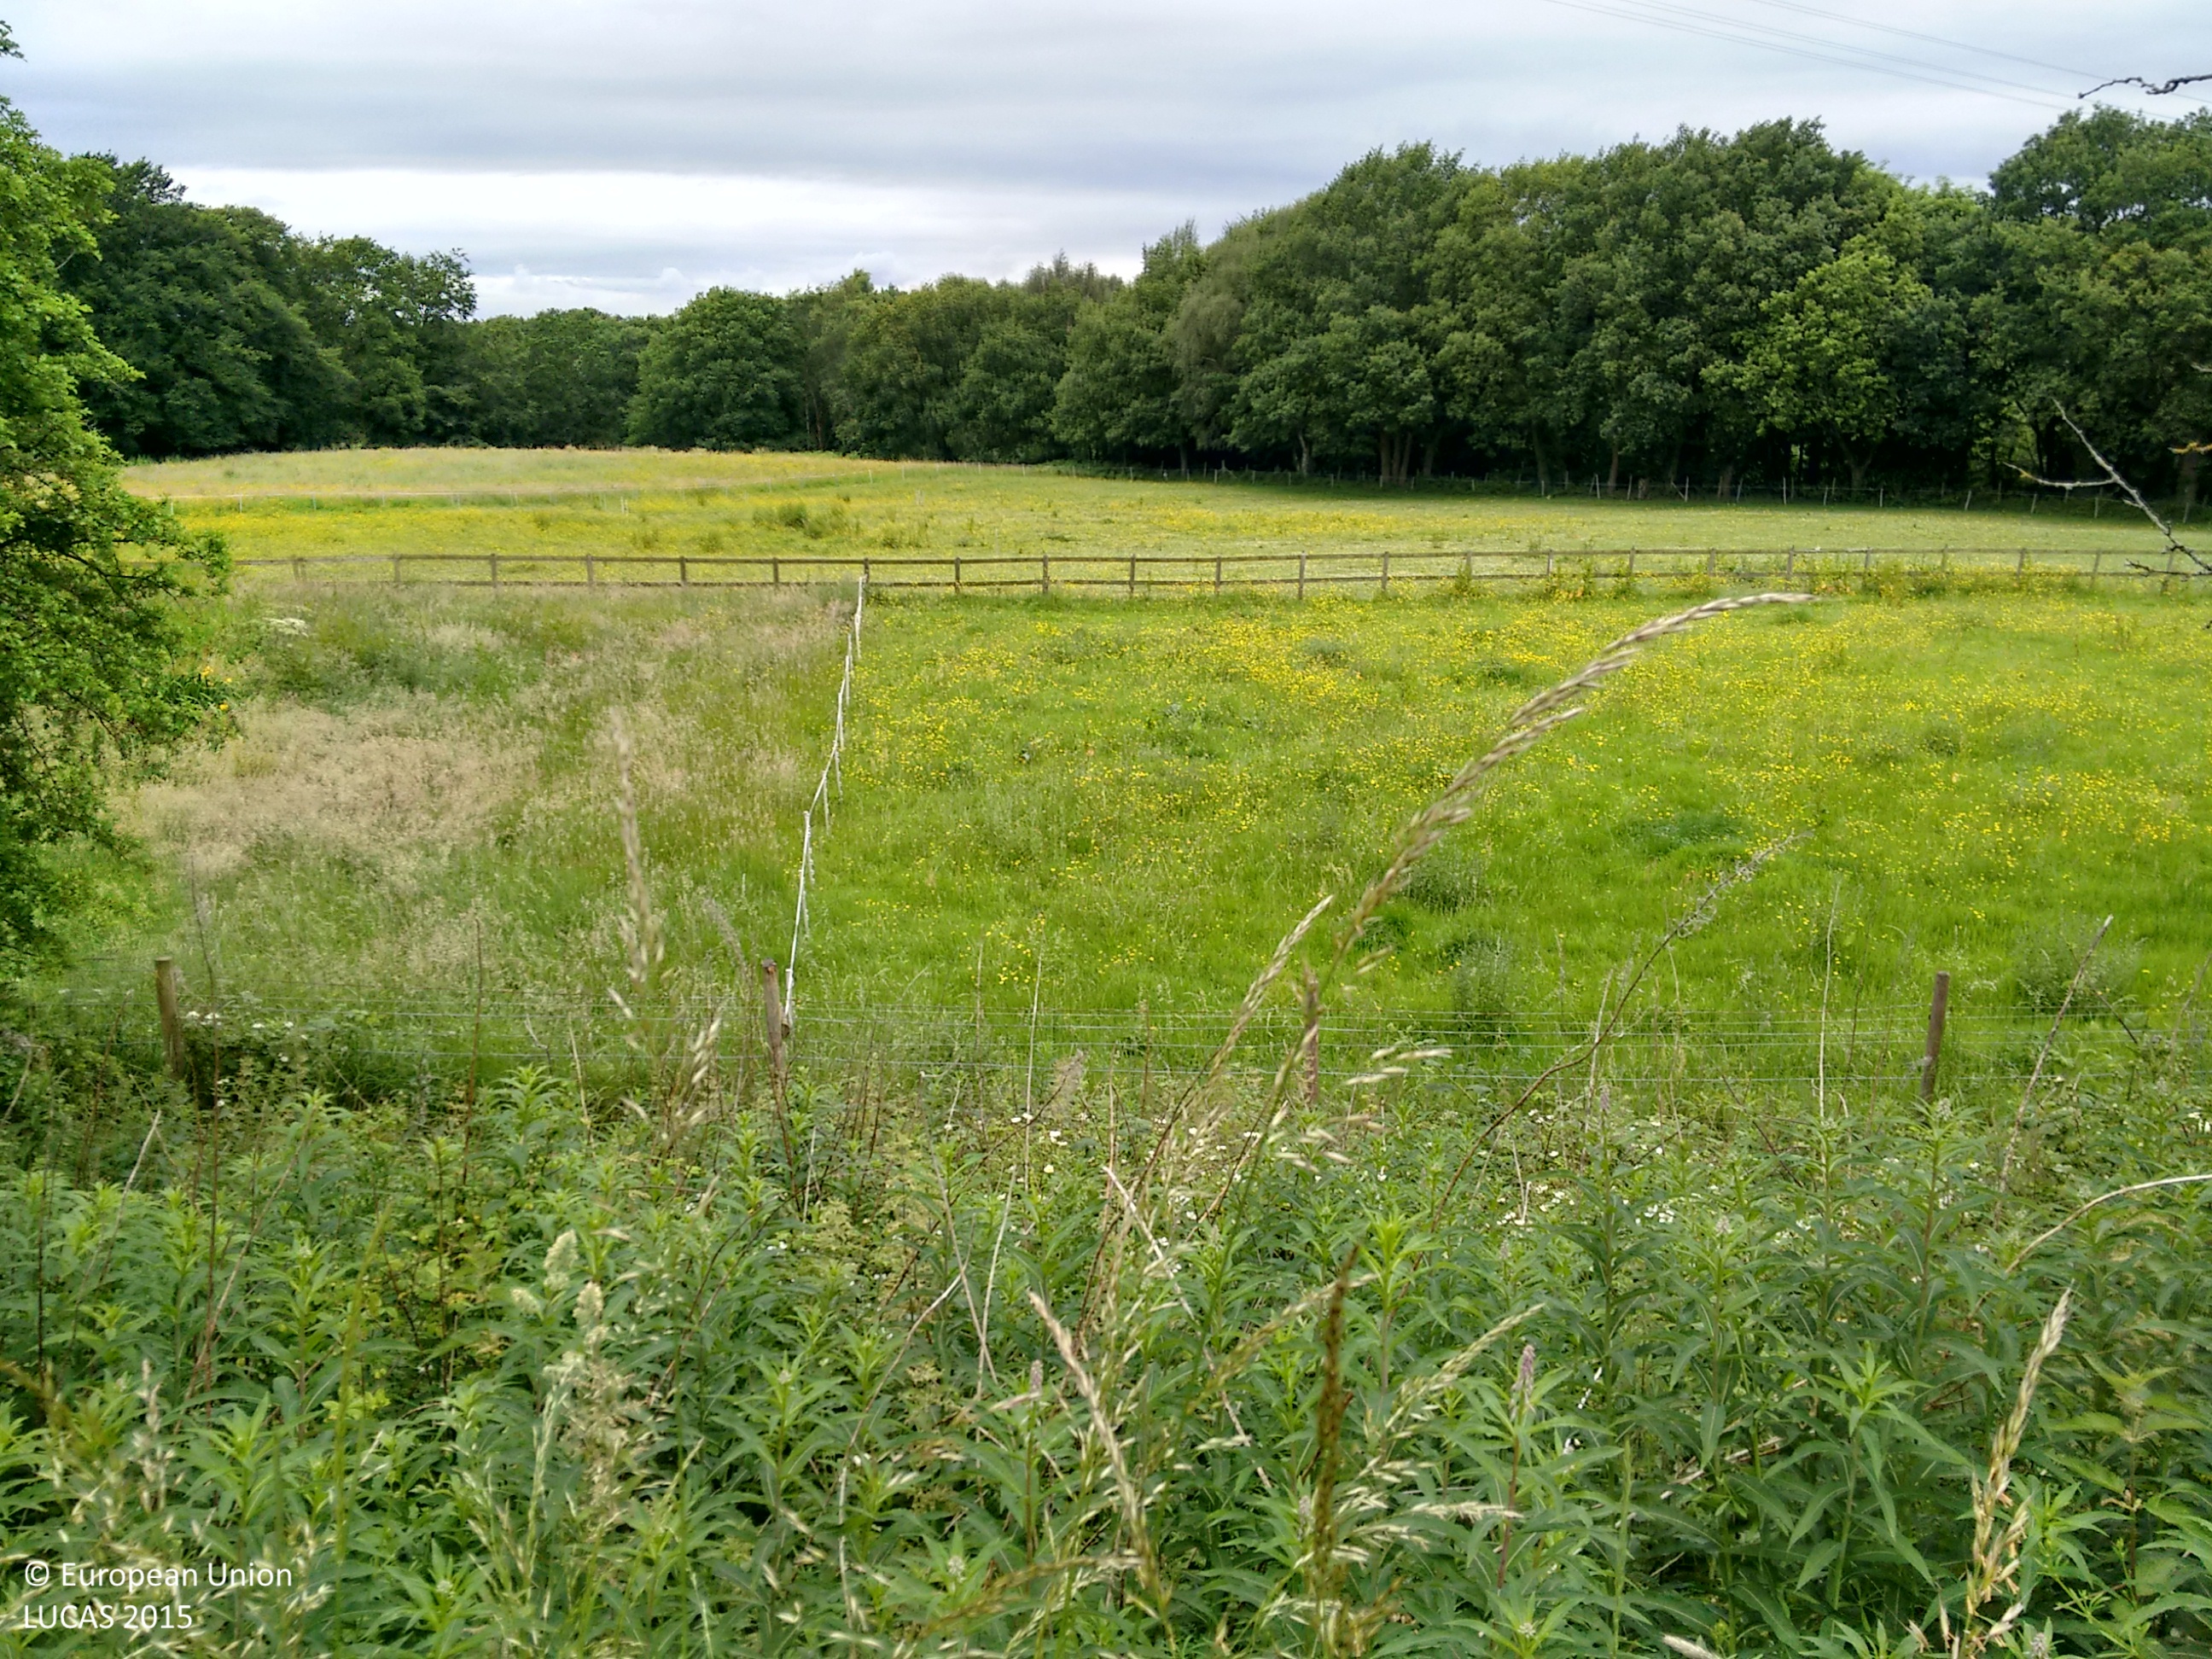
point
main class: Grassland
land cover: Grassland without tree/shrub cover
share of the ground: > 75 %
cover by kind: herbaceous plants 100 %
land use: Agriculture (excluding fallow land and kitchen gardens)
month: July
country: GB
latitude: 53.3393
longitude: -2.0890
